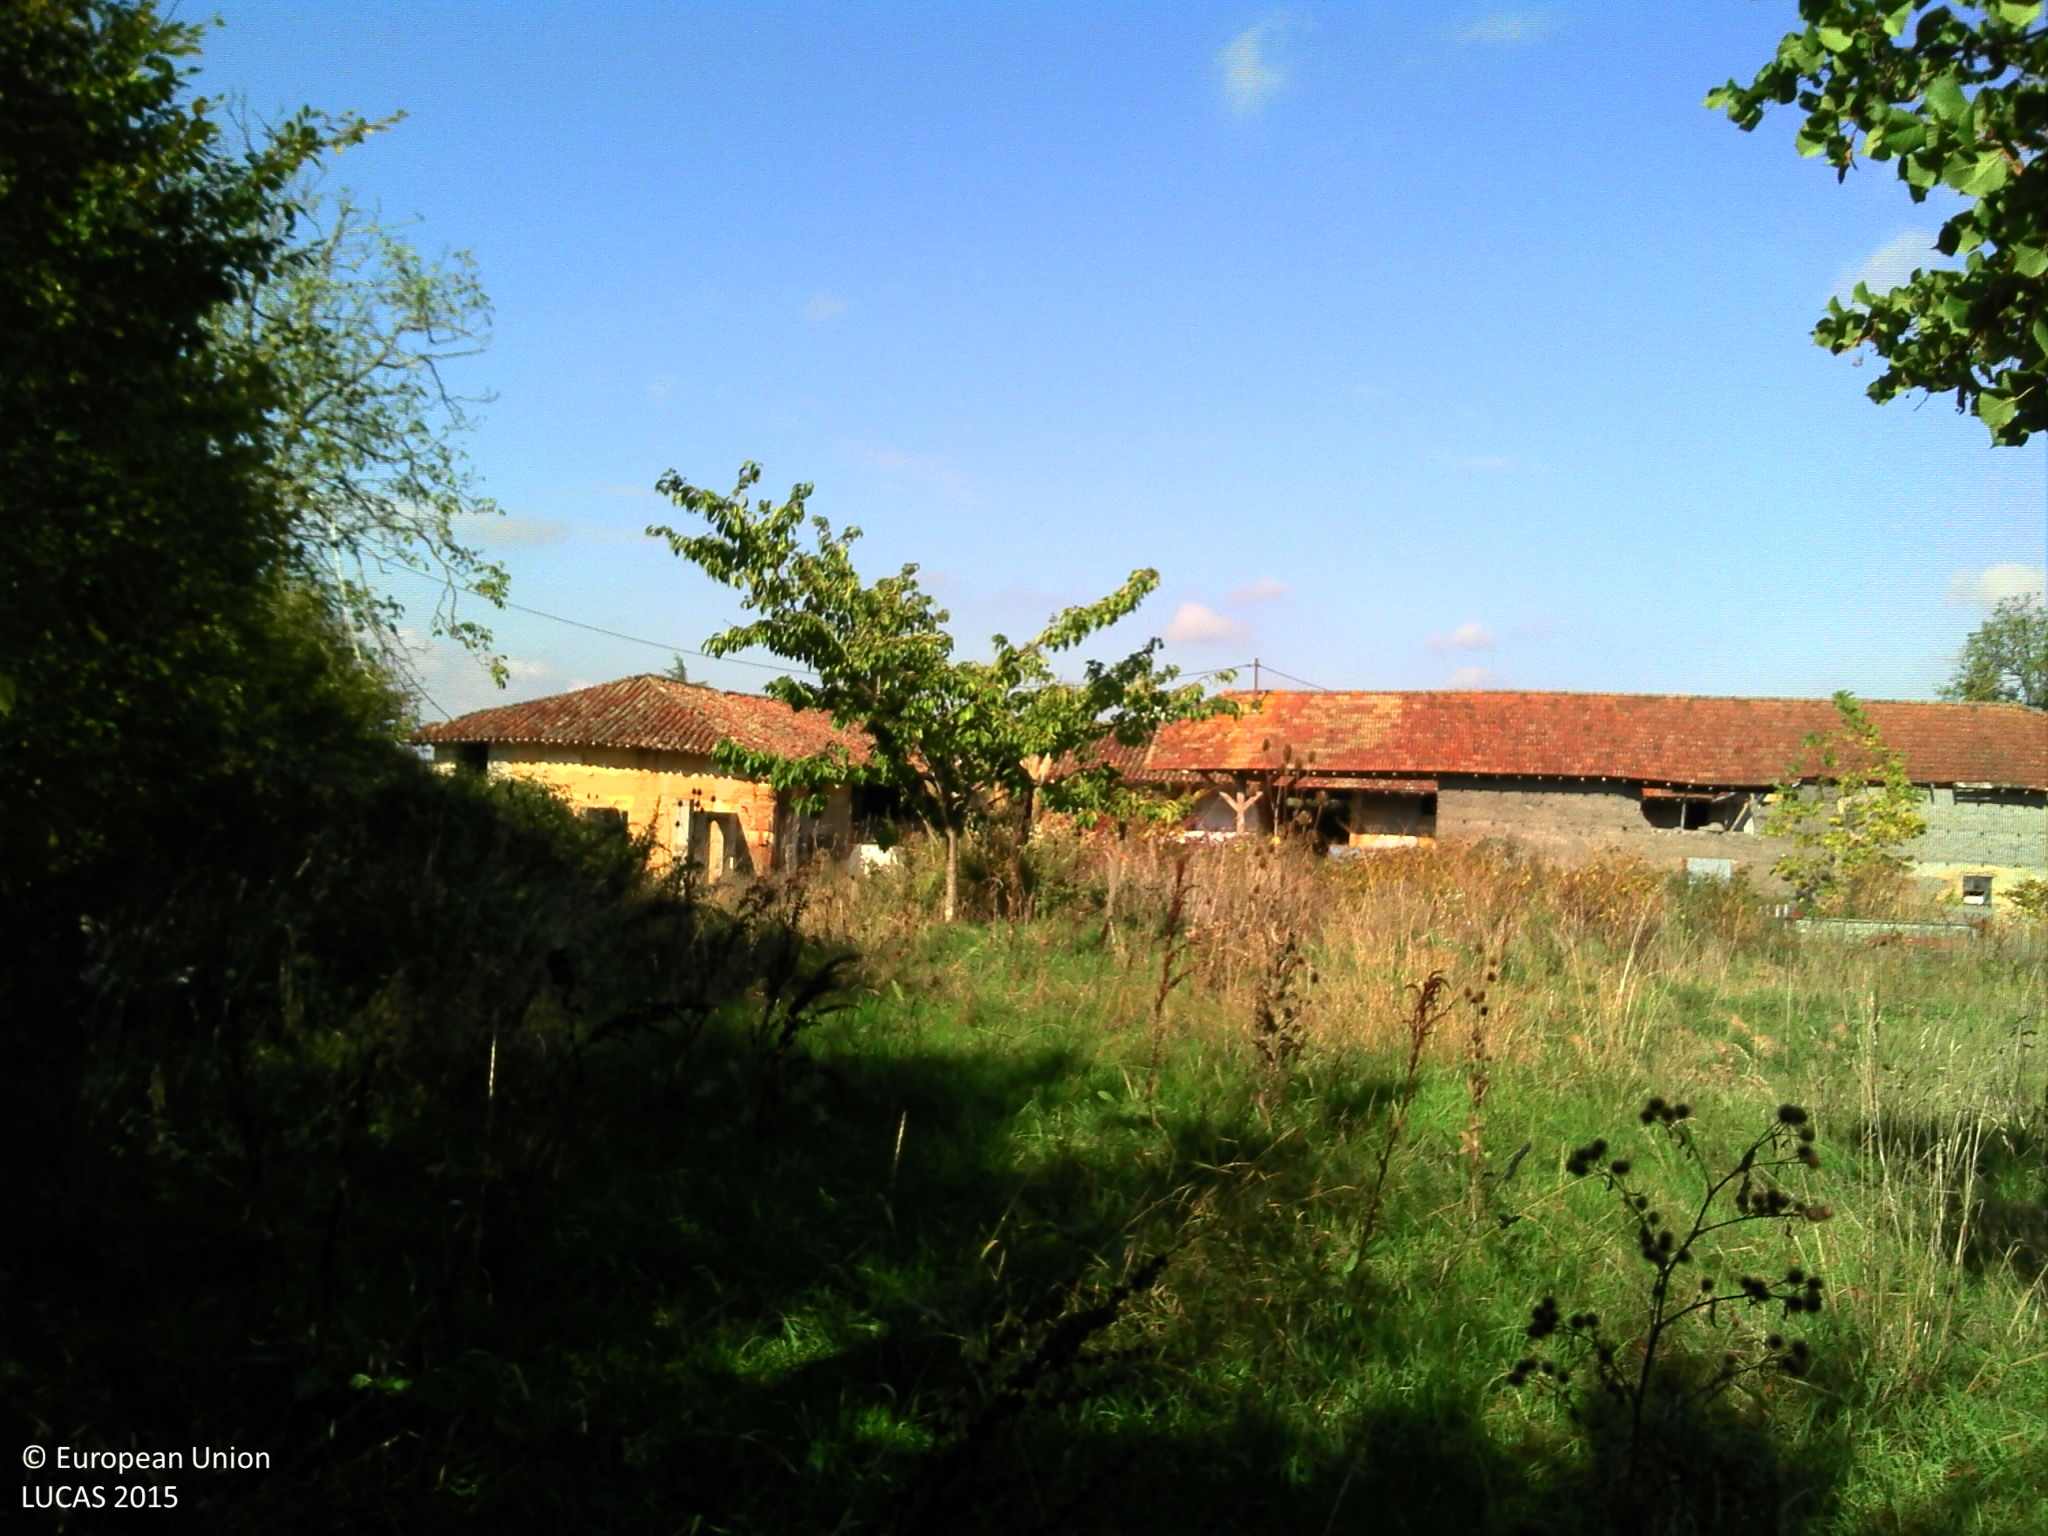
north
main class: Grassland
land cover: Spontaneously vegetated surfaces
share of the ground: > 75 %
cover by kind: herbaceous plants 100 %
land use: Abandoned areas
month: October
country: FR
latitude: 46.2287
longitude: 4.8810
